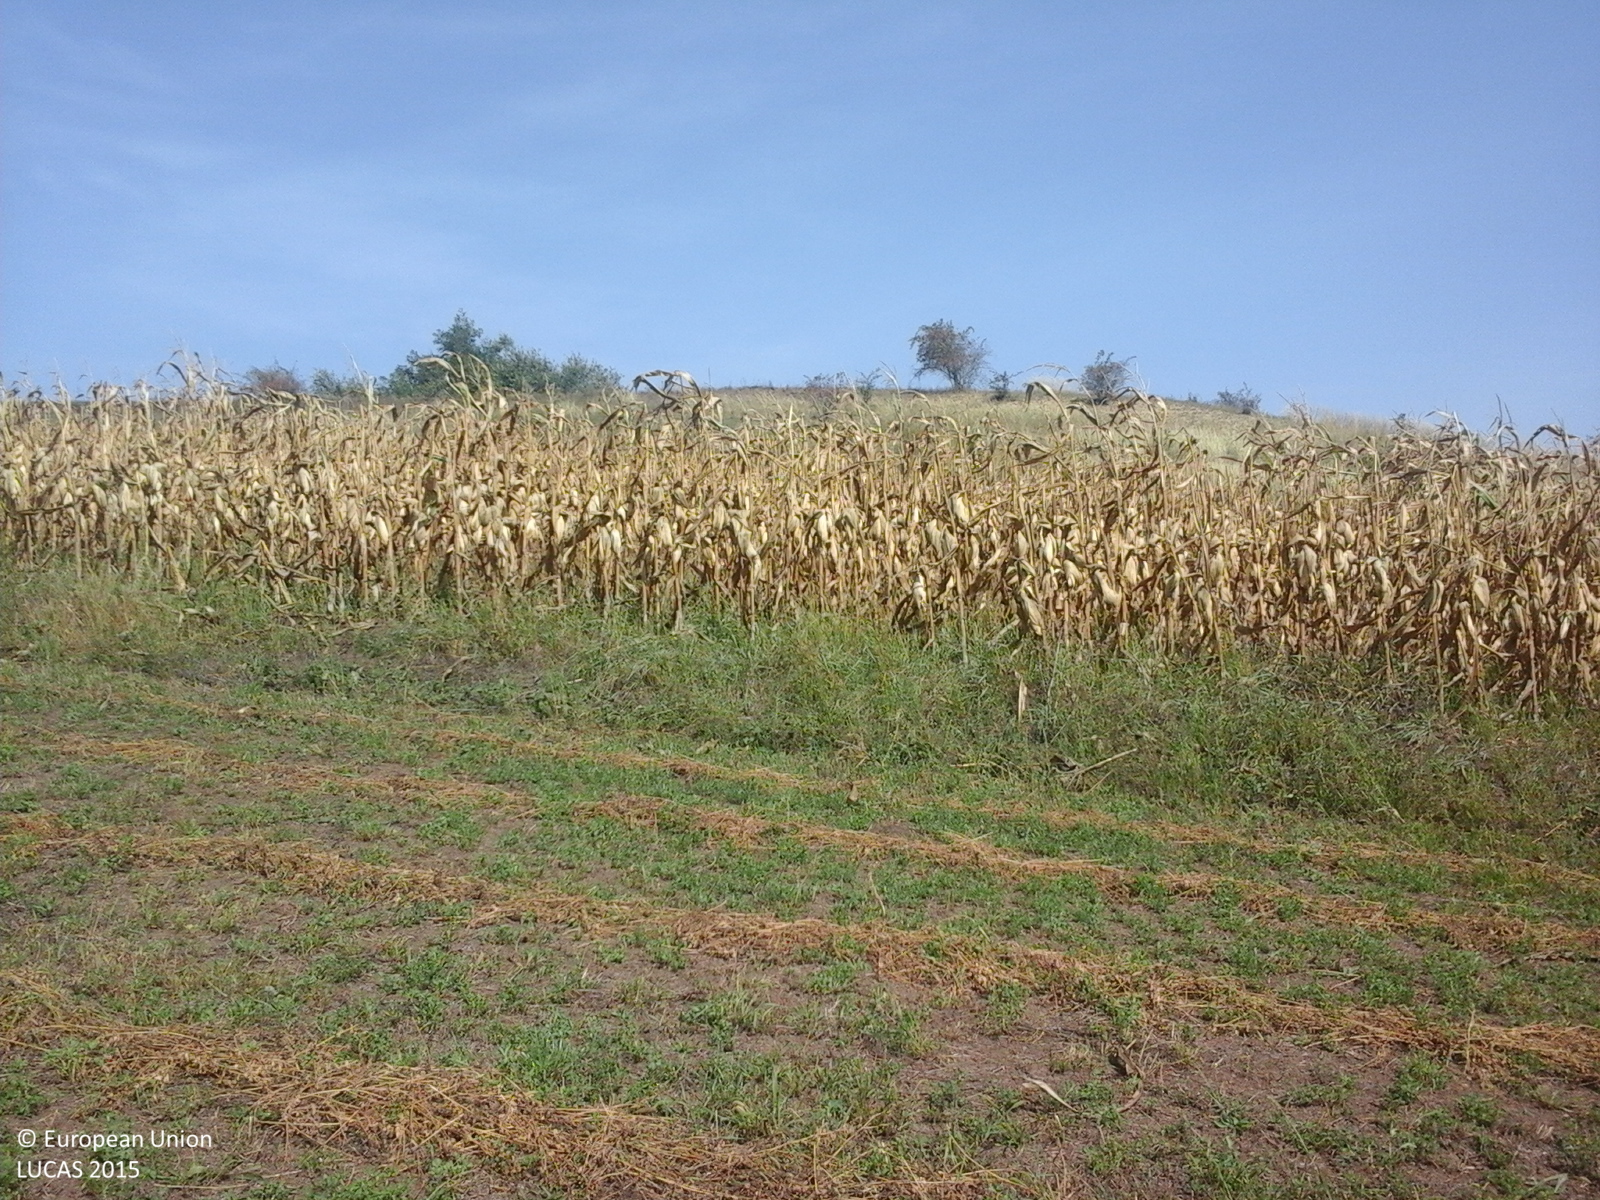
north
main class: Cropland
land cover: Lucerne
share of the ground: > 75 %
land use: Agriculture (excluding fallow land and kitchen gardens)
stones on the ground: < 10 %
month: September
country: RO
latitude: 46.6538
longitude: 24.1009
